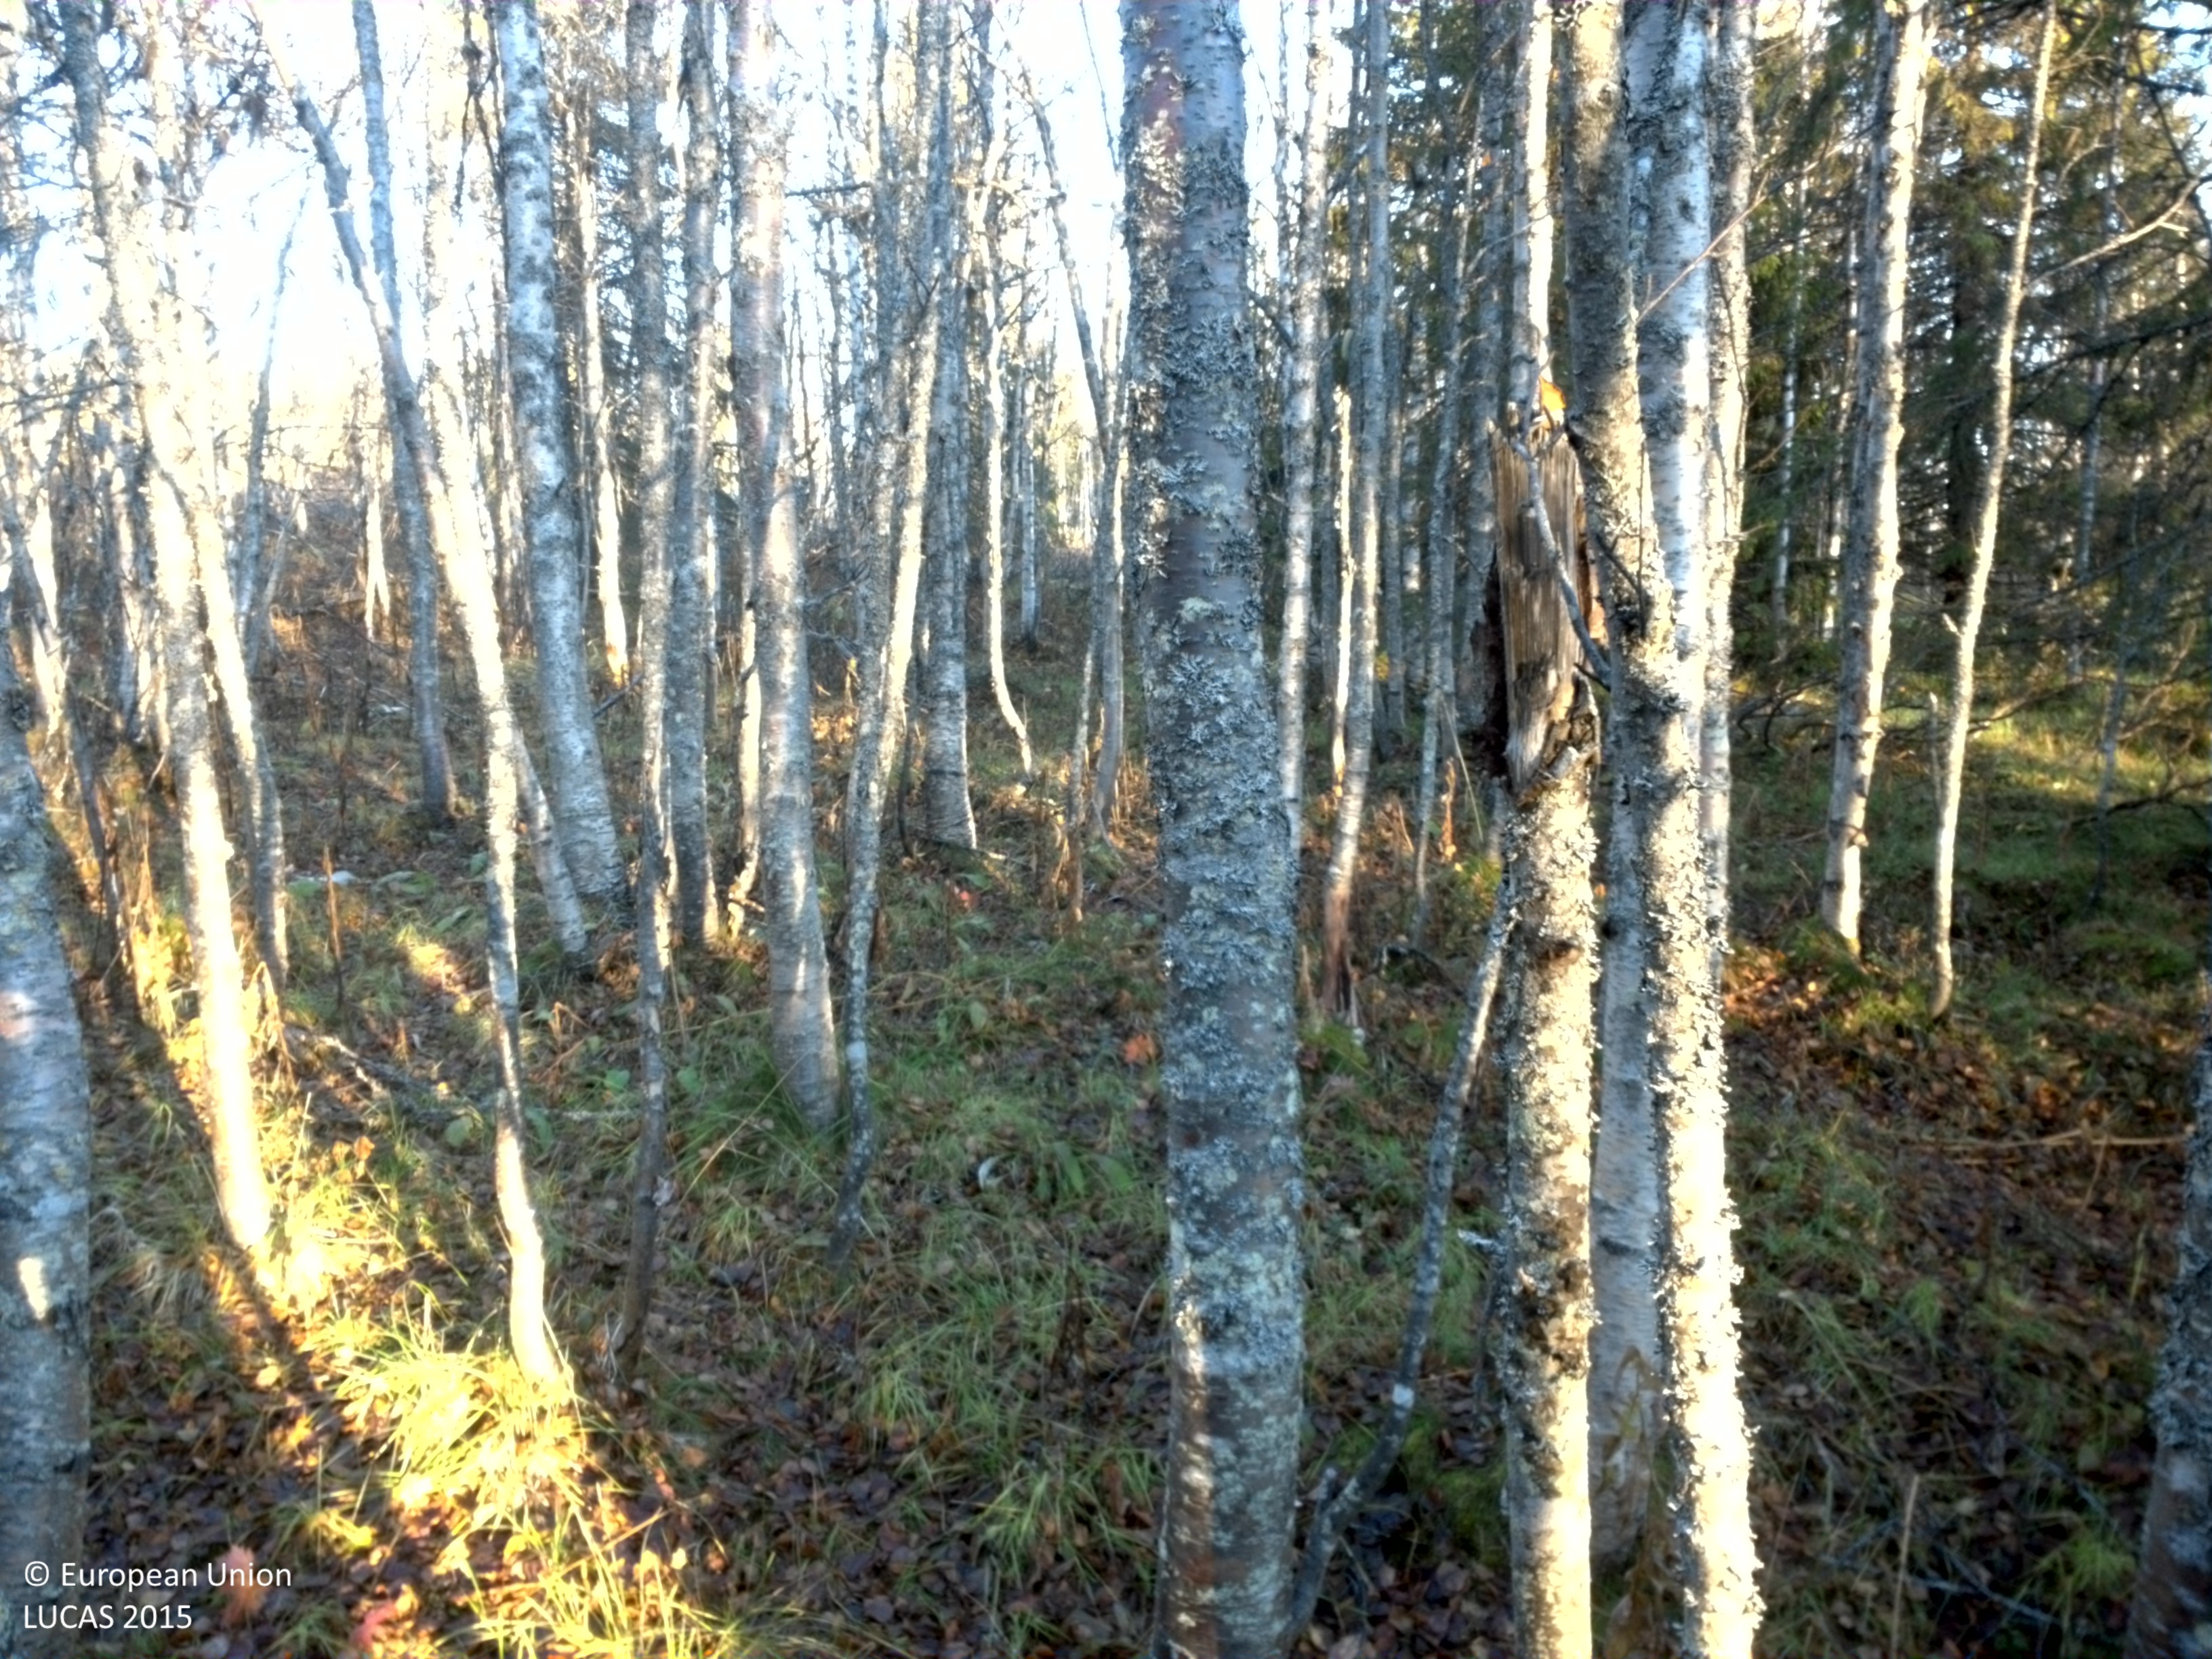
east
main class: Woodland
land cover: Broadleaved woodland
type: non-riverine alder, birch or aspen forest
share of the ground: 50 - 75 %
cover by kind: broadleaved forest trees 50 %, herbaceous plants 30 %, coniferous forest trees 10 %, shrubs 5 %, lichens and mosses 5 %
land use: Forestry
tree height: > 5 m
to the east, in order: Broadleaved woodland; Shrubland with sparse tree cover; Artificial constructions in urban areas; Grassland with sparse tree/shrub cover; Spontaneously vegetated surfaces; Broadleaved woodland; Grassland without tree/shrub cover; Broadleaved woodland; Spontaneously vegetated surfaces; Grassland without tree/shrub cover
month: October
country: SE
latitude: 64.7347
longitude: 17.3781
